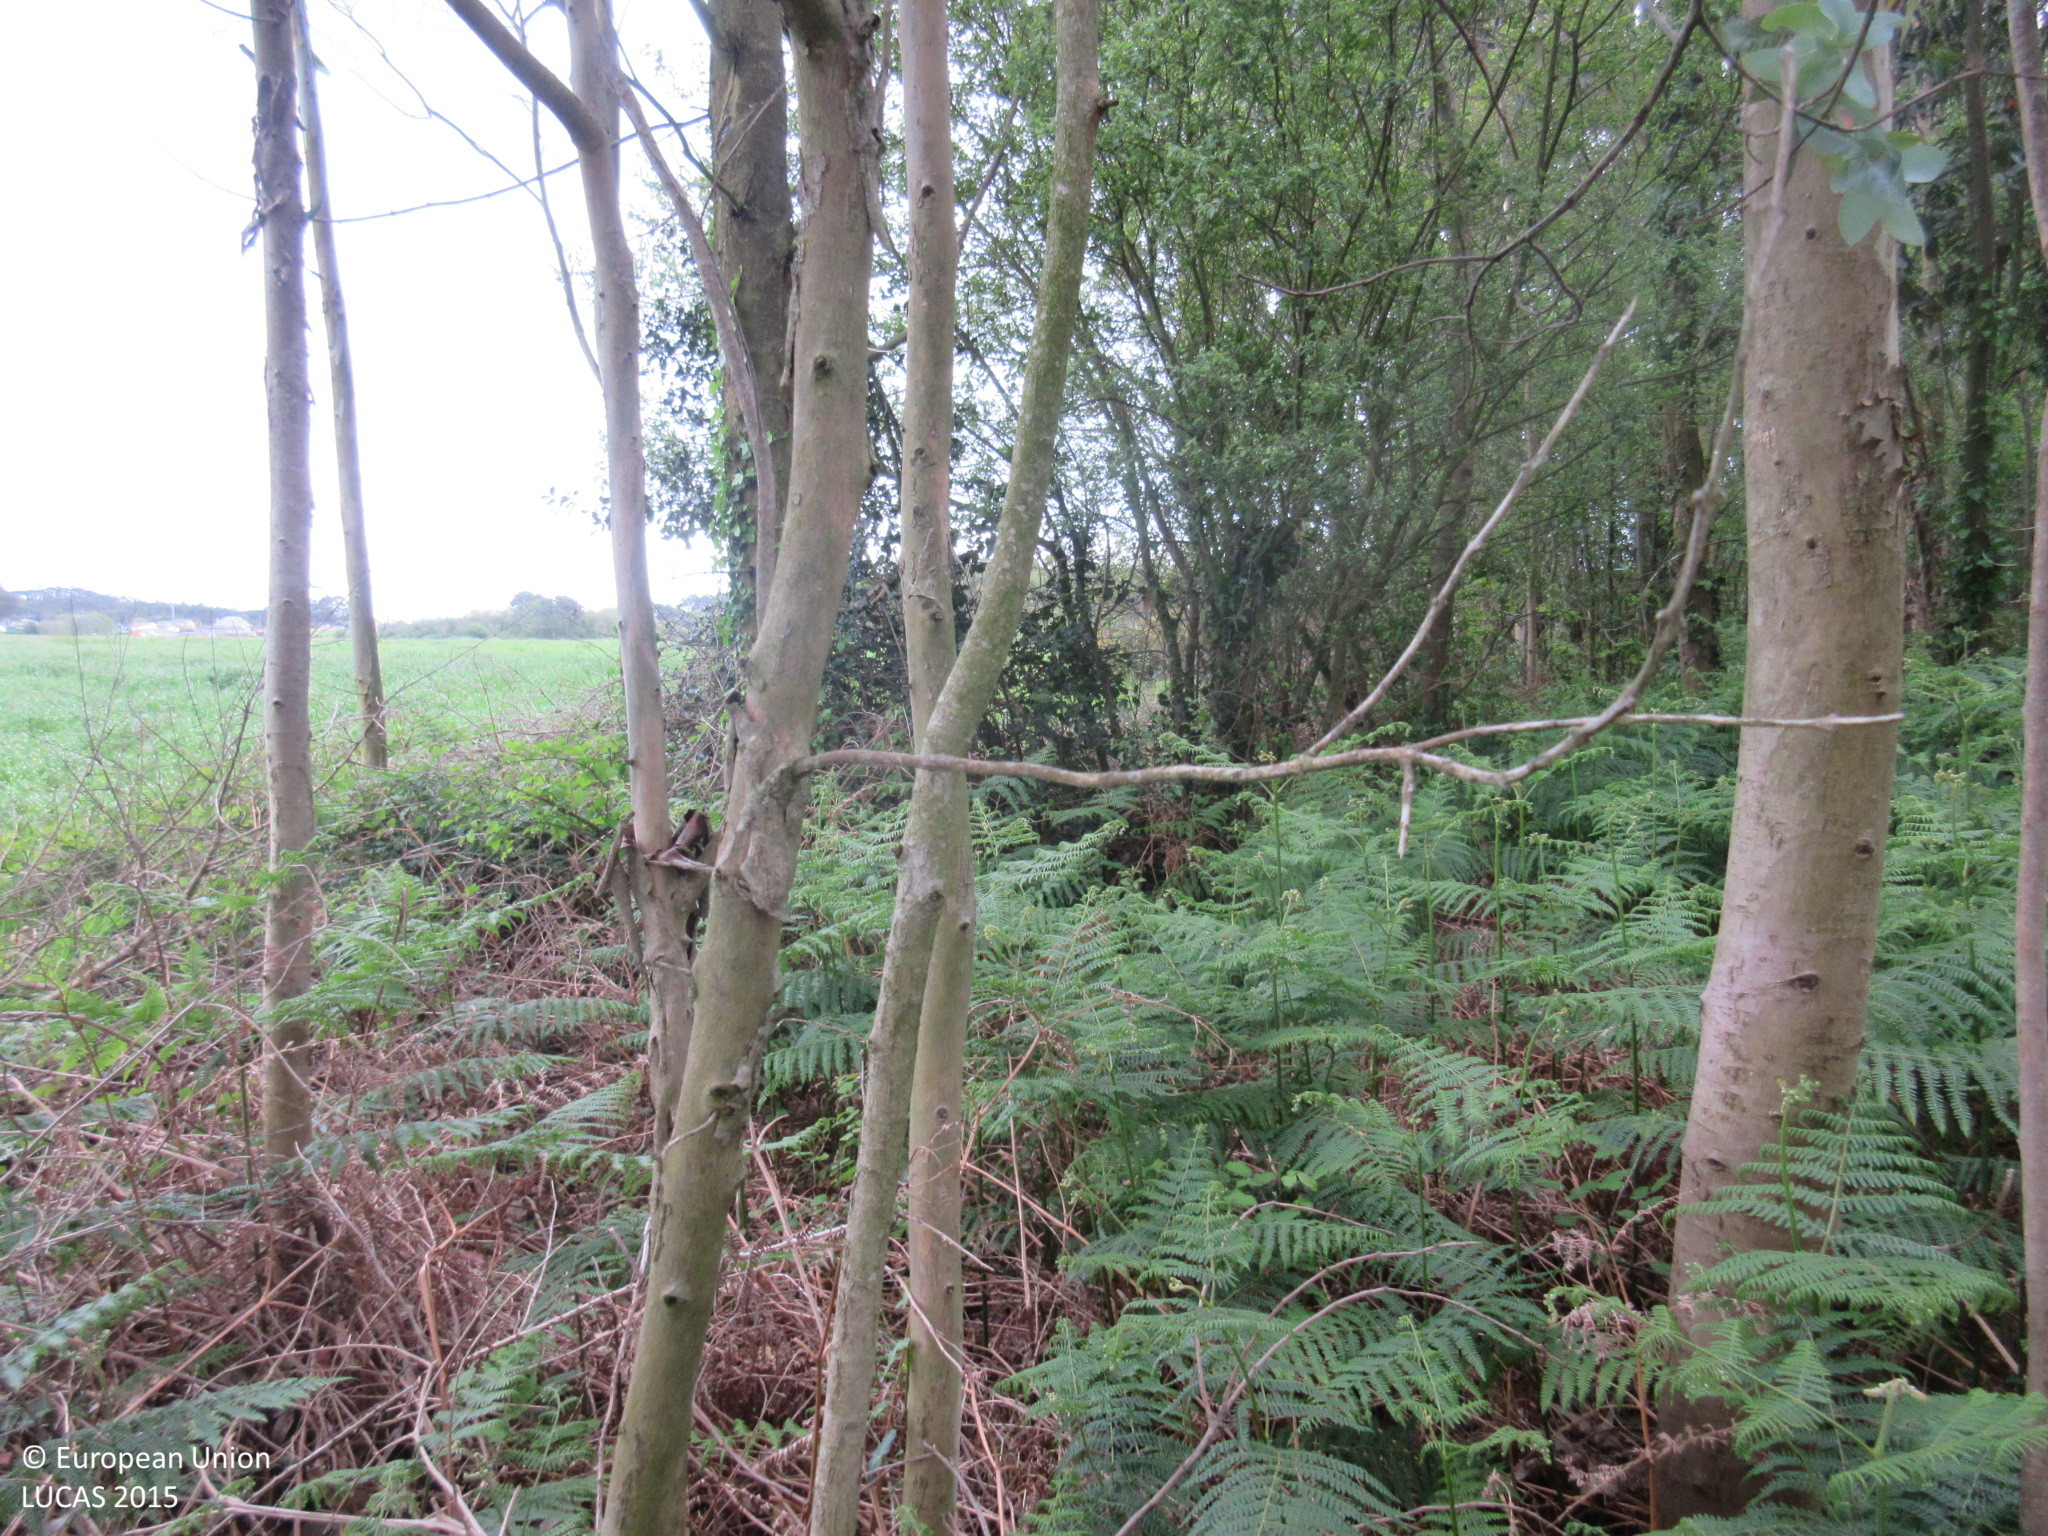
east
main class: Woodland
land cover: Broadleaved woodland
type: exotic forest
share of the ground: > 75 %
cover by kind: broadleaved forest trees 95 %, shrubs 5 %
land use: Forestry
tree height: > 5 m
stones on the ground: < 10 %
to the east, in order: Broadleaved woodland; Grassland without tree/shrub cover; Broadleaved woodland; Grass margins; Tracks; Grass margins; Other bare soil
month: April
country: ES
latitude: 43.5418
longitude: -7.1132
